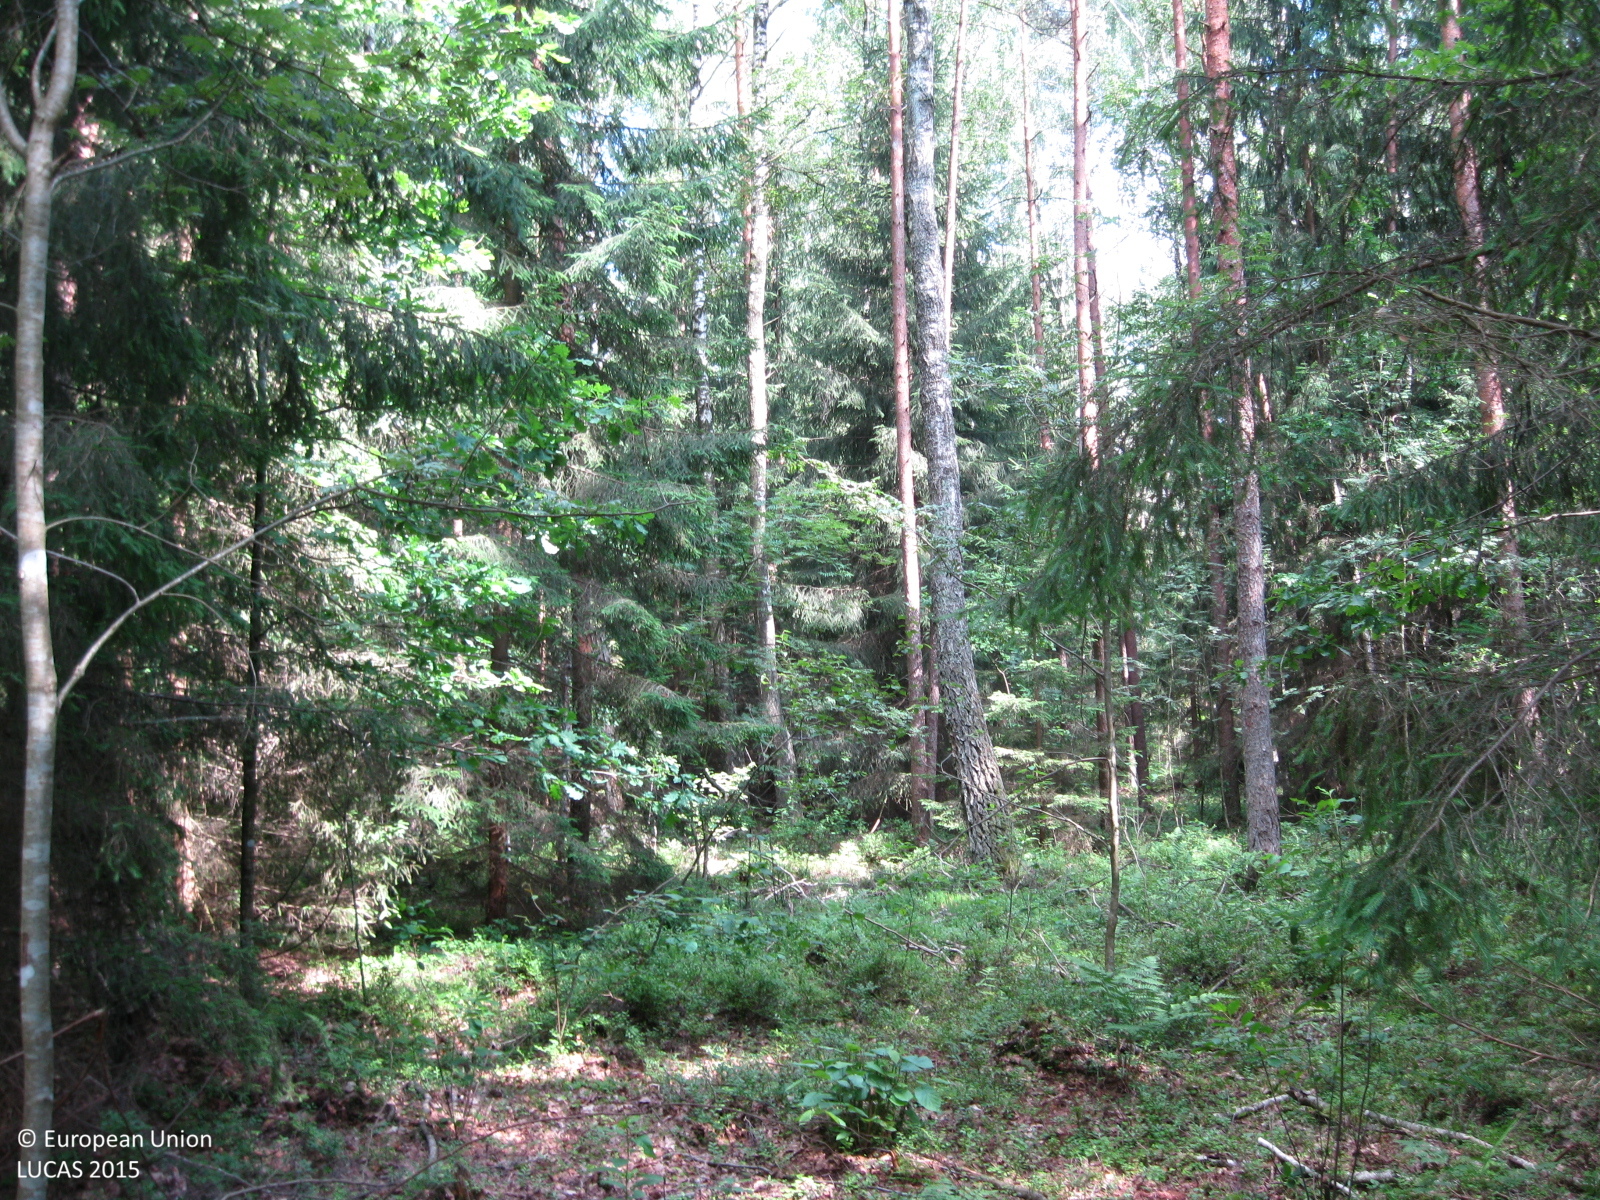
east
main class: Woodland
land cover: Other mixed woodland
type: hemiboreal forest and nemoral coniferous forest and mixed broadleaved-coniferous forest
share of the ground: > 75 %
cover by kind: coniferous forest trees 50 %, broadleaved forest trees 30 %, shrubs 10 %, lichens and mosses 10 %
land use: Forestry
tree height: > 5 m
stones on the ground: < 10 %
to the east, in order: Other mixed woodland; Spruce dominated mixed woodland
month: July
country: LT
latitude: 55.5574
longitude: 24.6735
